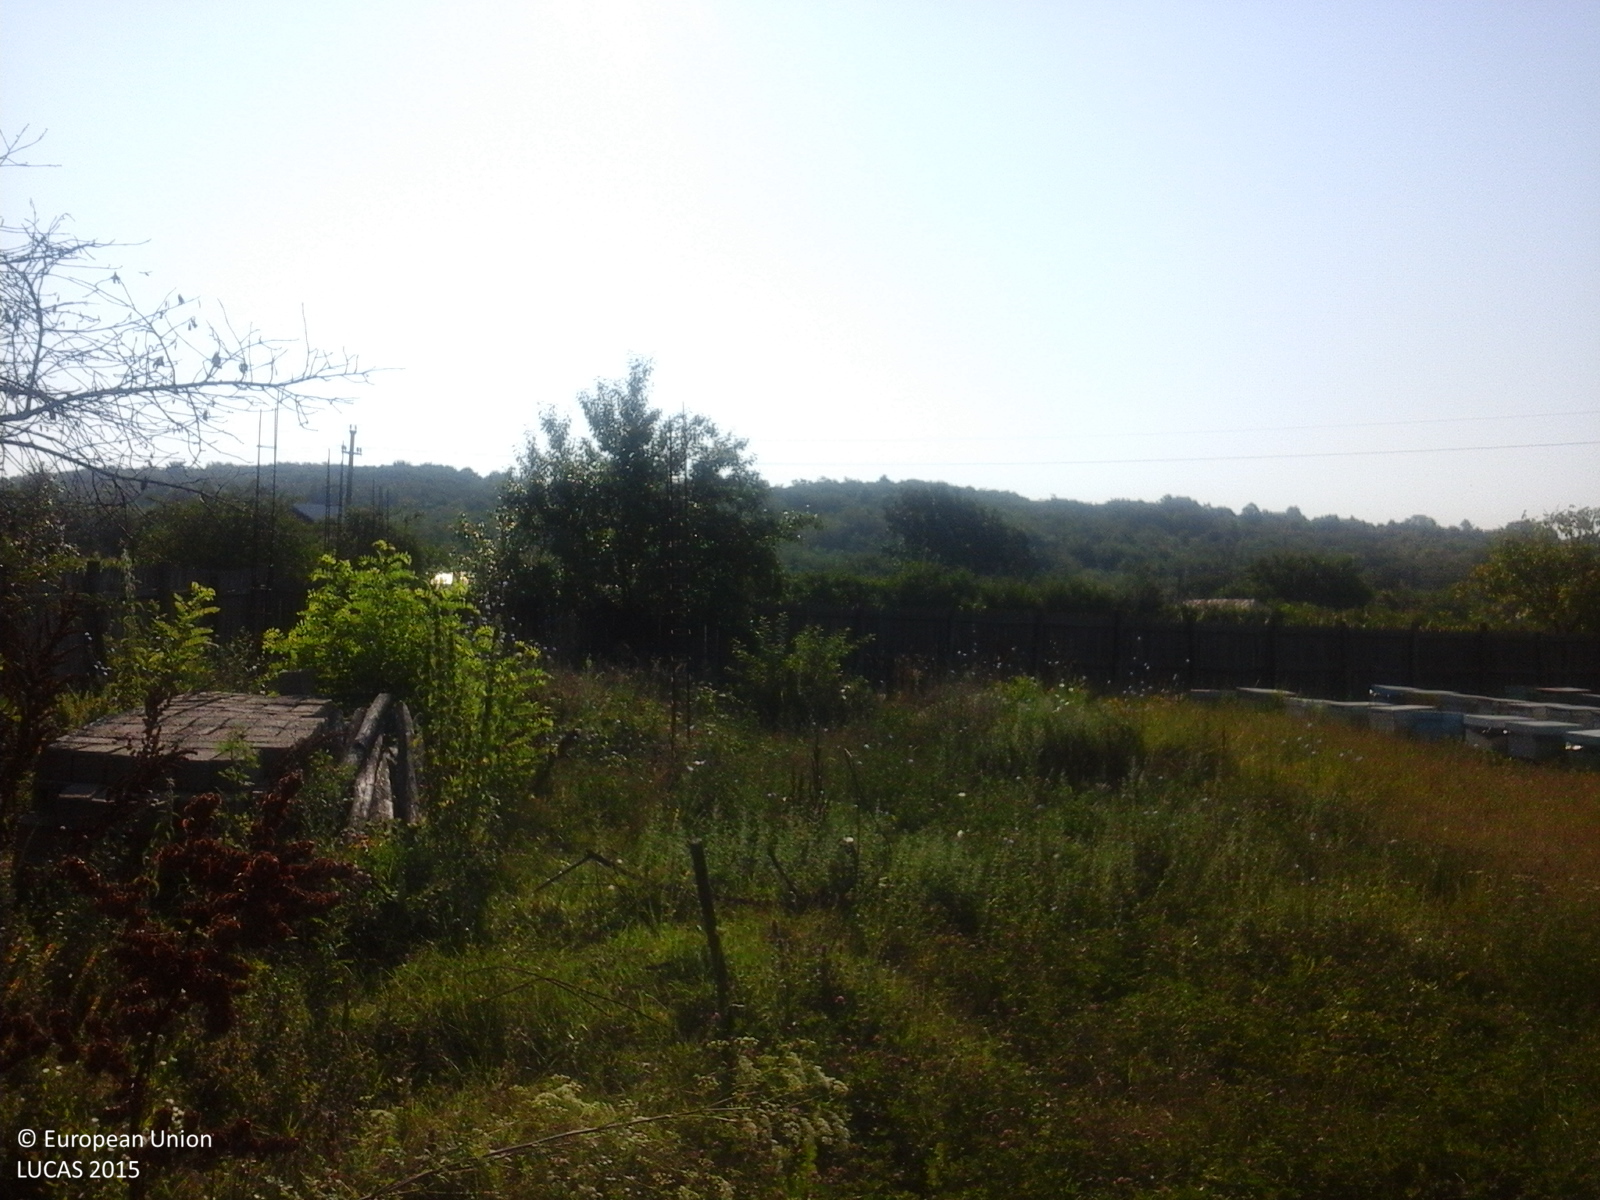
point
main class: Cropland
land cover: Common wheat
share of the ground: > 75 %
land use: Agriculture (excluding fallow land and kitchen gardens)
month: July
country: RO
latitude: 44.7547
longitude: 24.3575
